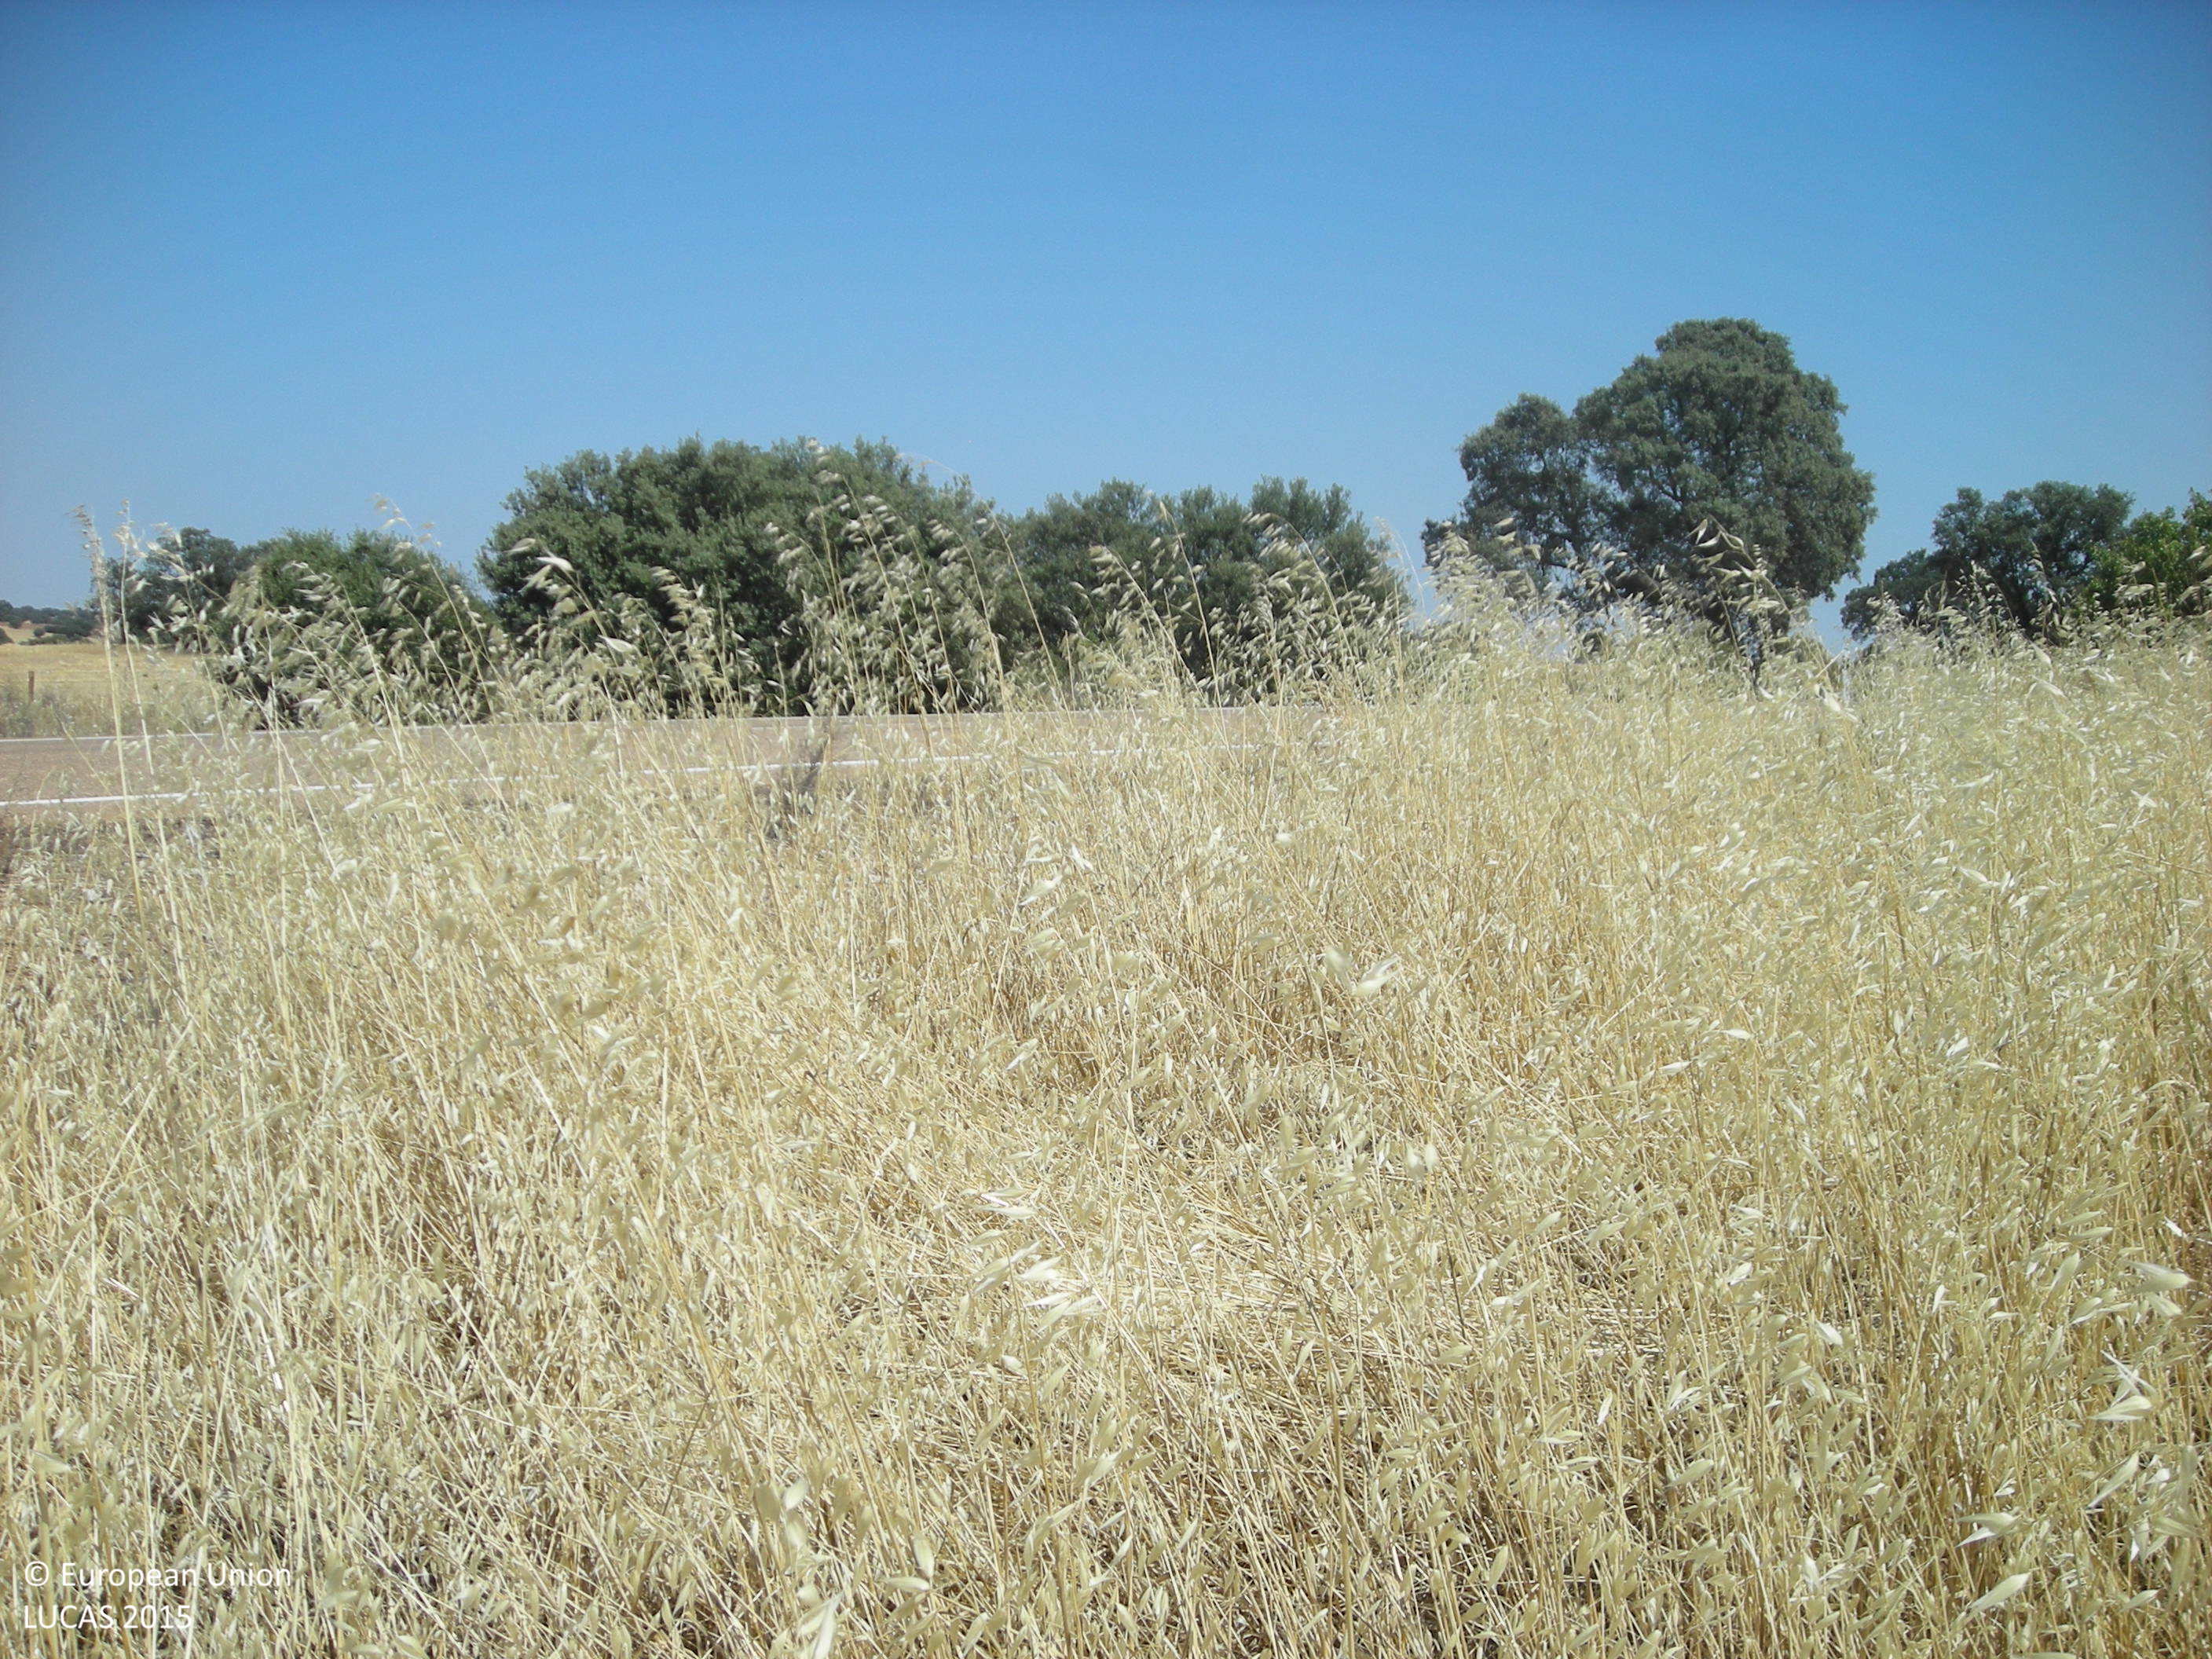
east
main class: Grassland
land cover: Grassland without tree/shrub cover
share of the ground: > 75 %
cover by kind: herbaceous plants 100 %
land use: Agriculture (excluding fallow land and kitchen gardens)
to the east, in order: Grassland without tree/shrub cover; Fences; Shruby margins; Grassland without tree/shrub cover
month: June
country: ES
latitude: 38.6148
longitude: -5.8812
